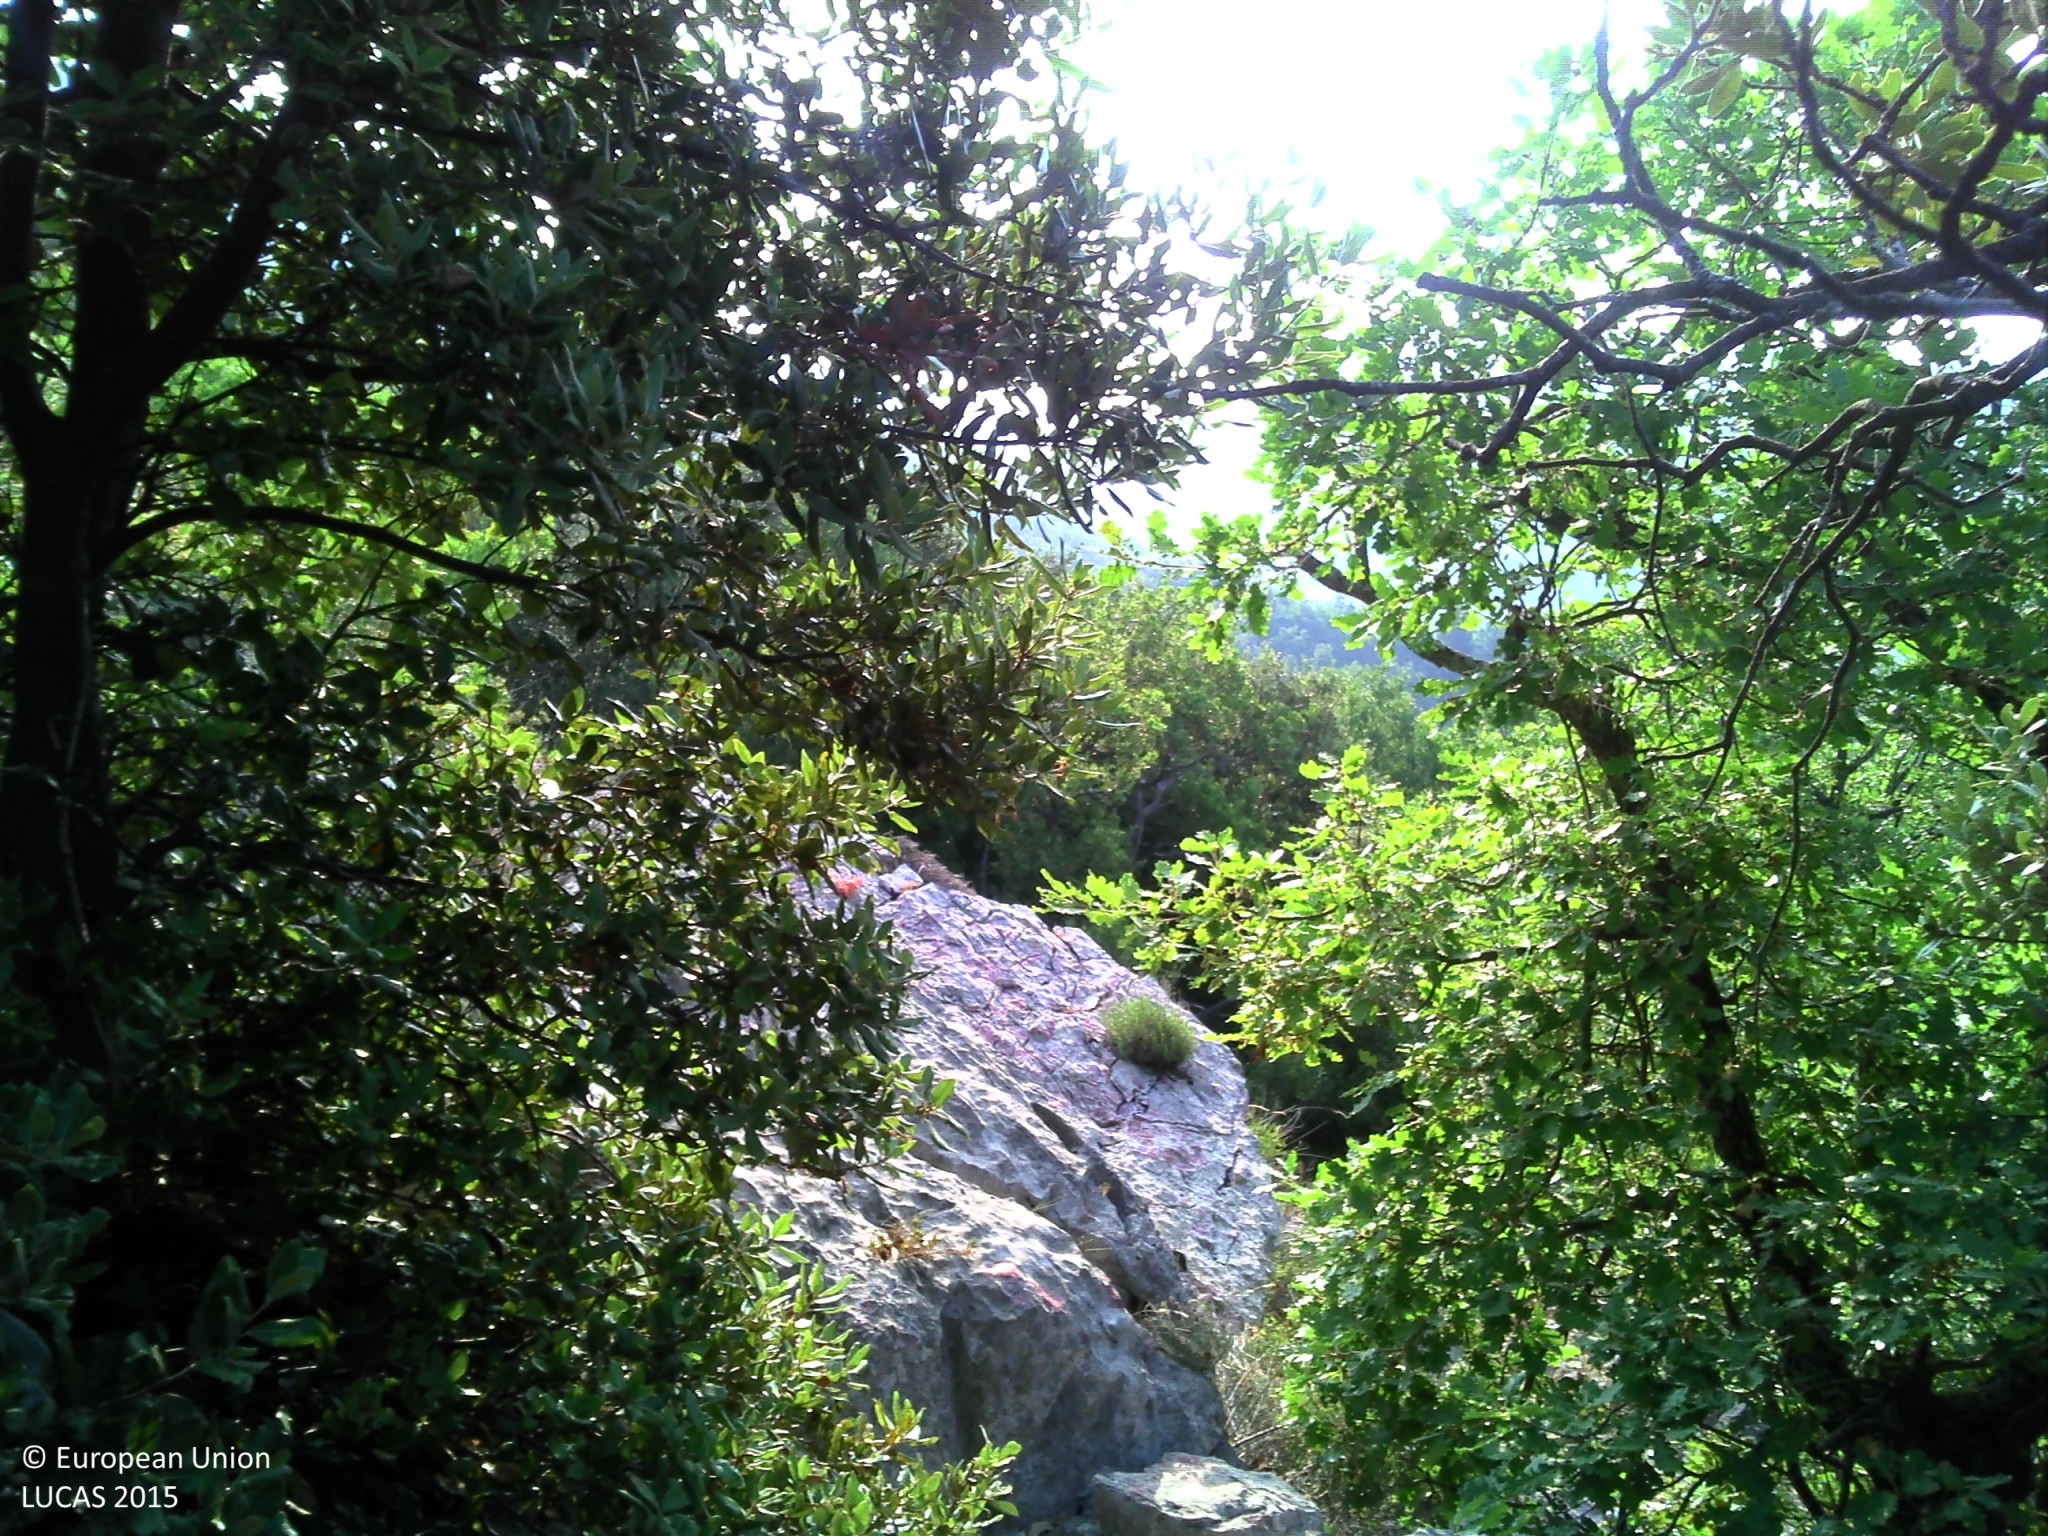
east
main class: Woodland
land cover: Broadleaved woodland
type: broadleaved evergreen forest
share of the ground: 25 - 50 %
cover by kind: broadleaved forest trees 35 %, shrubs 30 %, consolidated bare surface 20 %, herbaceous plants 10 %, unconsolidated bare surface 5 %
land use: Semi-natural and natural areas not in use
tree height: > 5 m
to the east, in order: Broadleaved woodland; Rocks and stones; Broadleaved woodland; Dry stone walls; Broadleaved woodland; Shrubland with sparse tree cover
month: July
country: FR
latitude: 43.7068
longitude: 6.8430
